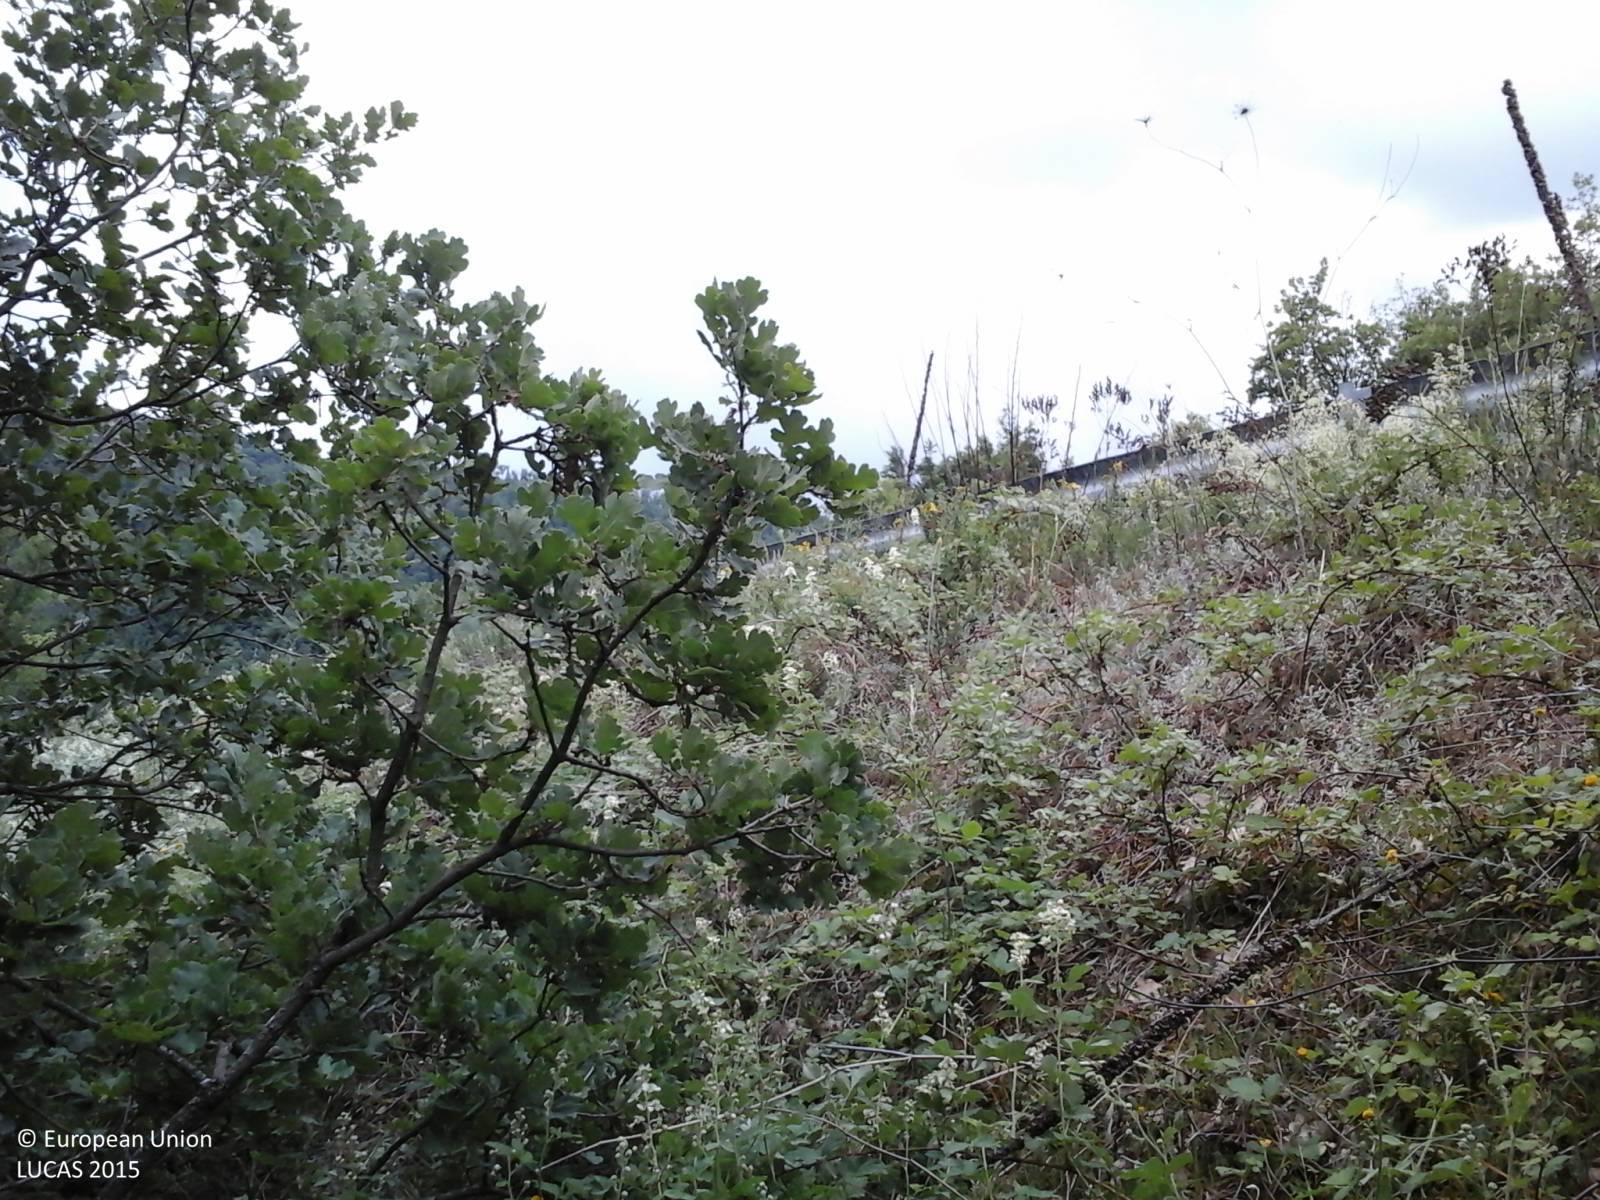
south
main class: Woodland
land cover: Broadleaved woodland
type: thermophilous deciduous forest
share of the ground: > 75 %
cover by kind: broadleaved forest trees 80 %, shrubs 20 %
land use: Semi-natural and natural areas not in use
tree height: > 5 m
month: June
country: IT
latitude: 42.0793
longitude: 13.7227
